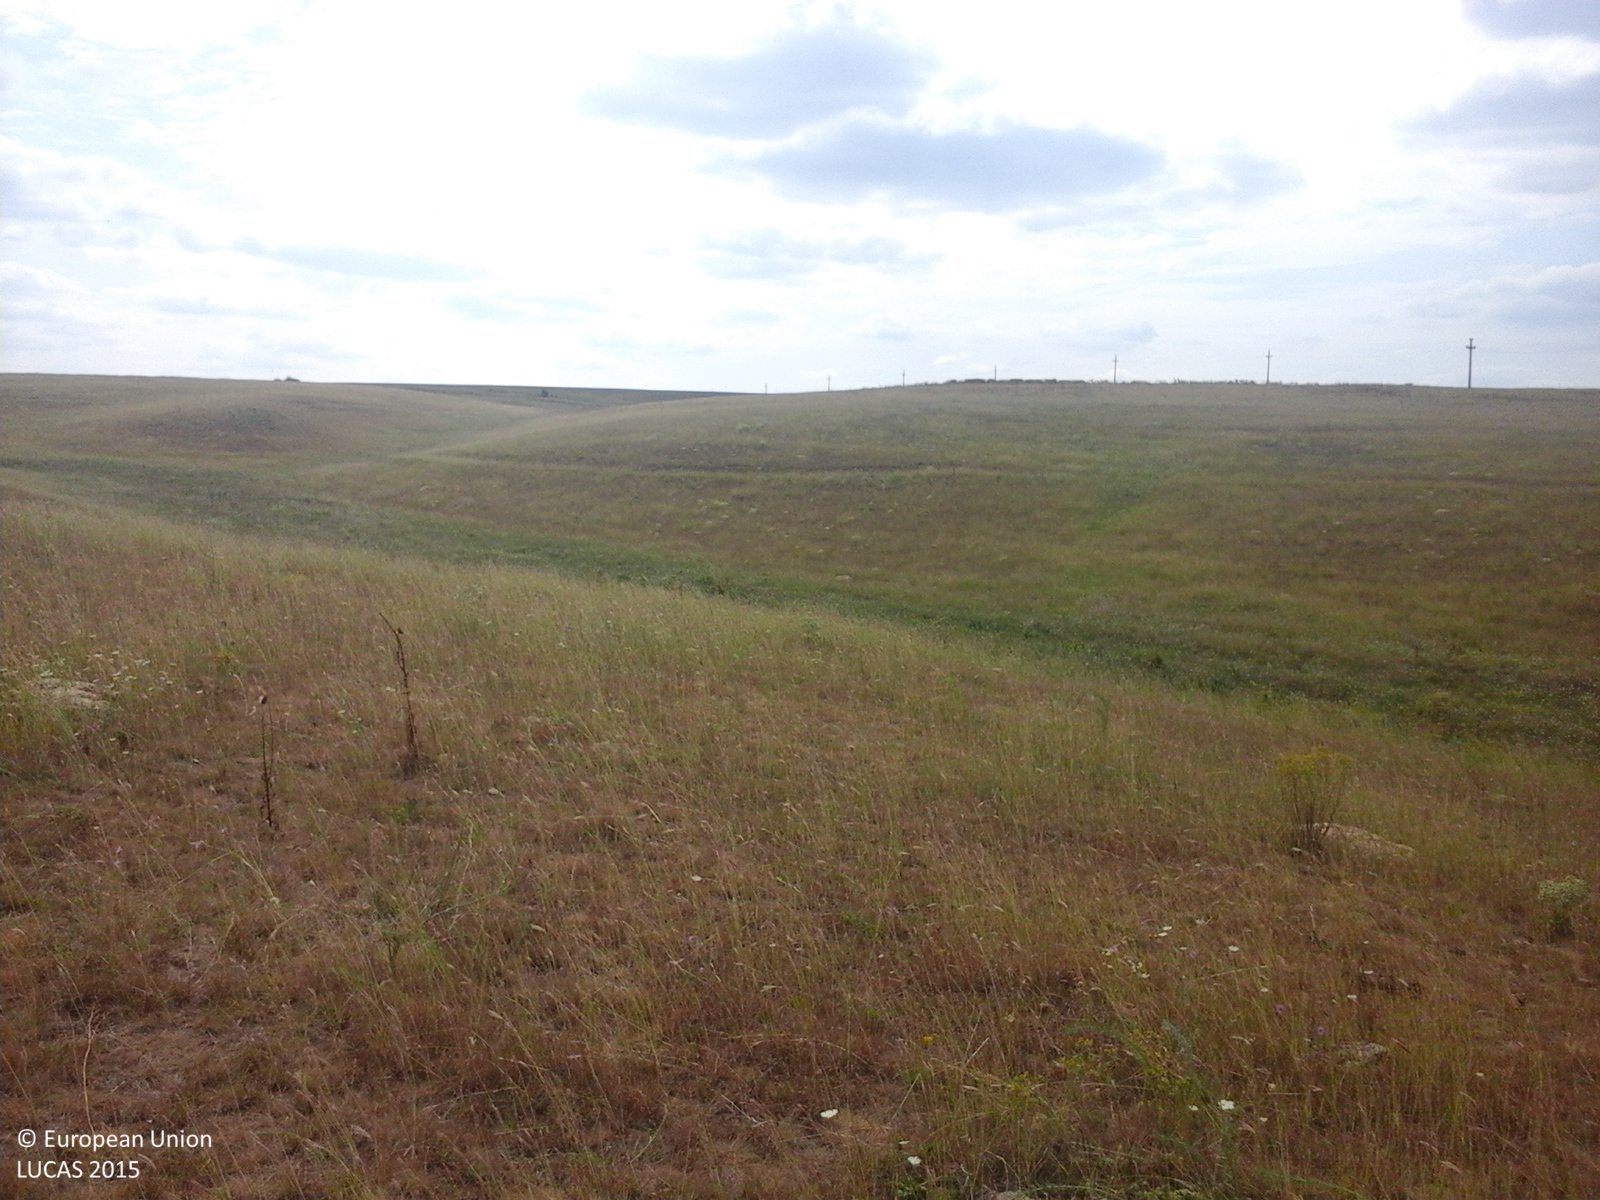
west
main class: Grassland
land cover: Grassland without tree/shrub cover
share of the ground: > 75 %
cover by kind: herbaceous plants 100 %
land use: Agriculture (excluding fallow land and kitchen gardens)
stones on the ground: < 10 %
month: August
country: RO
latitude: 44.7205
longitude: 28.1815
